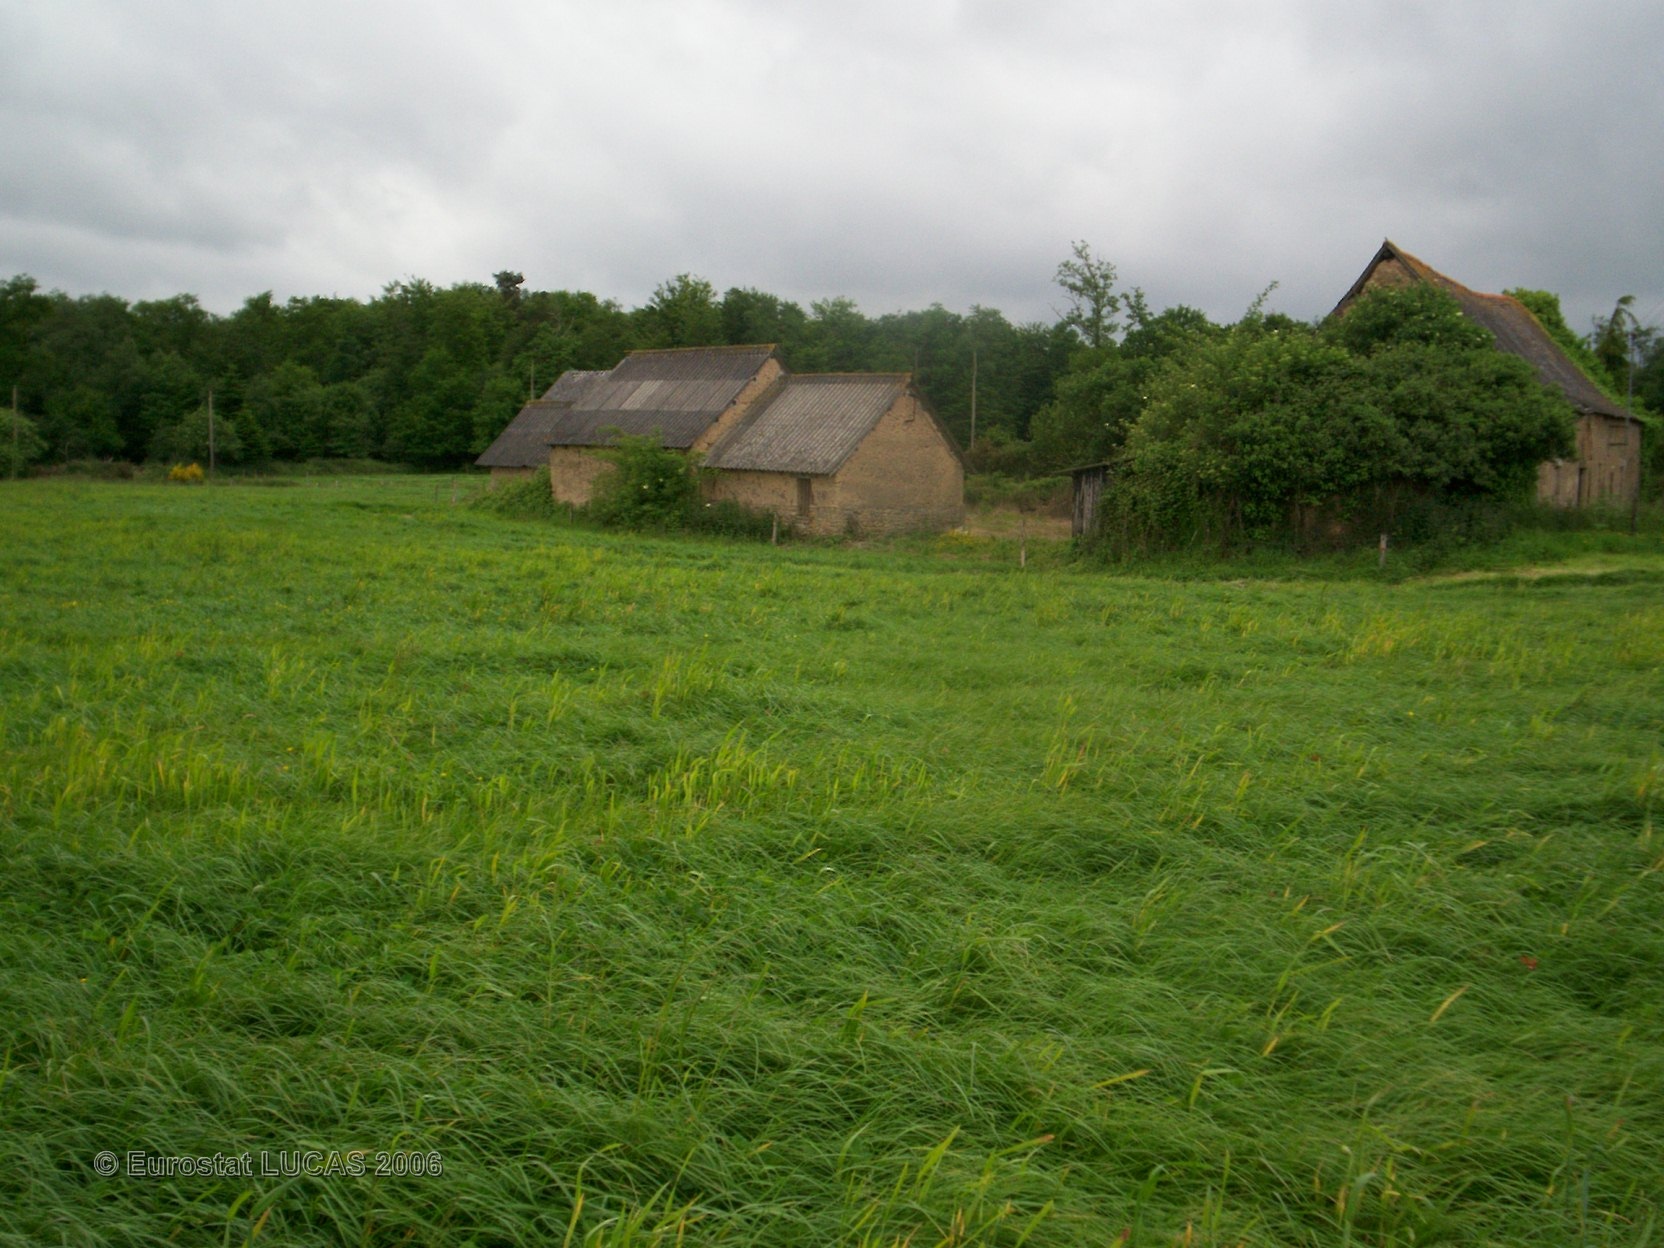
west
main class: Grassland
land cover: Grassland without tree/shrub cover
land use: Agriculture (excluding fallow land and kitchen gardens)
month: May
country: FR
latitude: 48.2534
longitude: -2.3552
